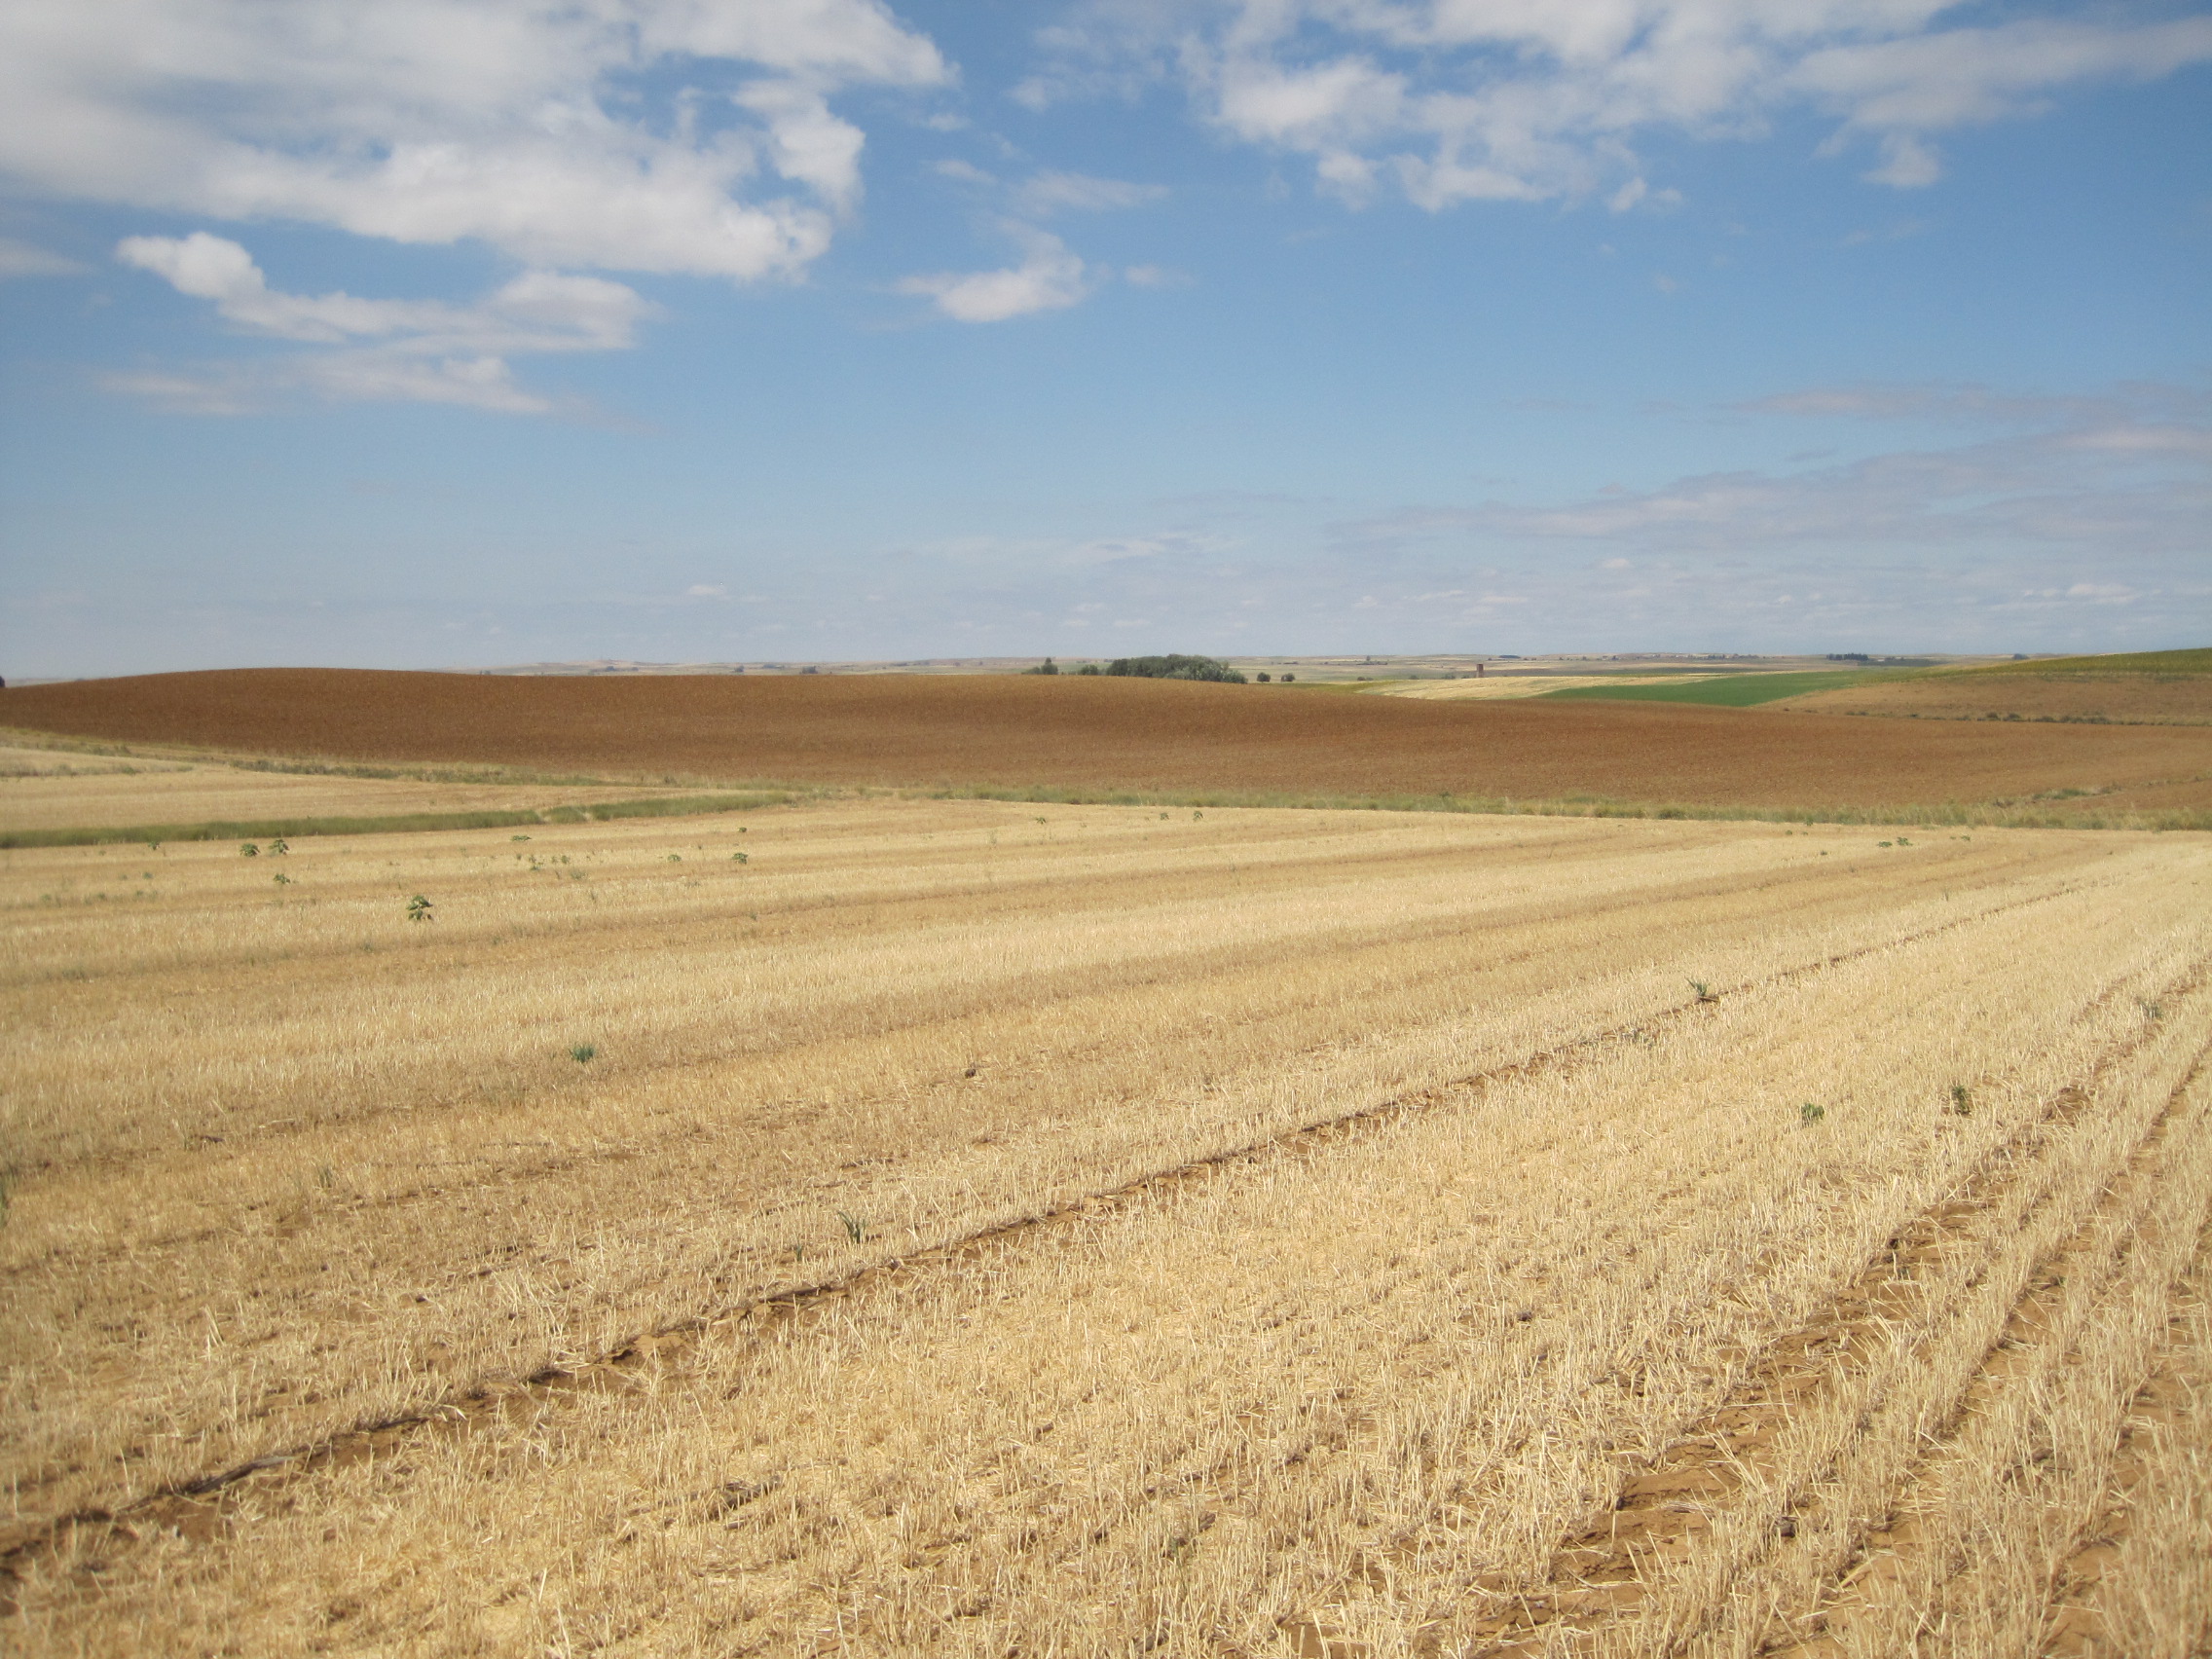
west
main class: Cropland
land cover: Barley
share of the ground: < 10 %
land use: Agriculture (excluding fallow land and kitchen gardens)
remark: Harvested field
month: July
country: ES
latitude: 42.0498
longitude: -5.1977
